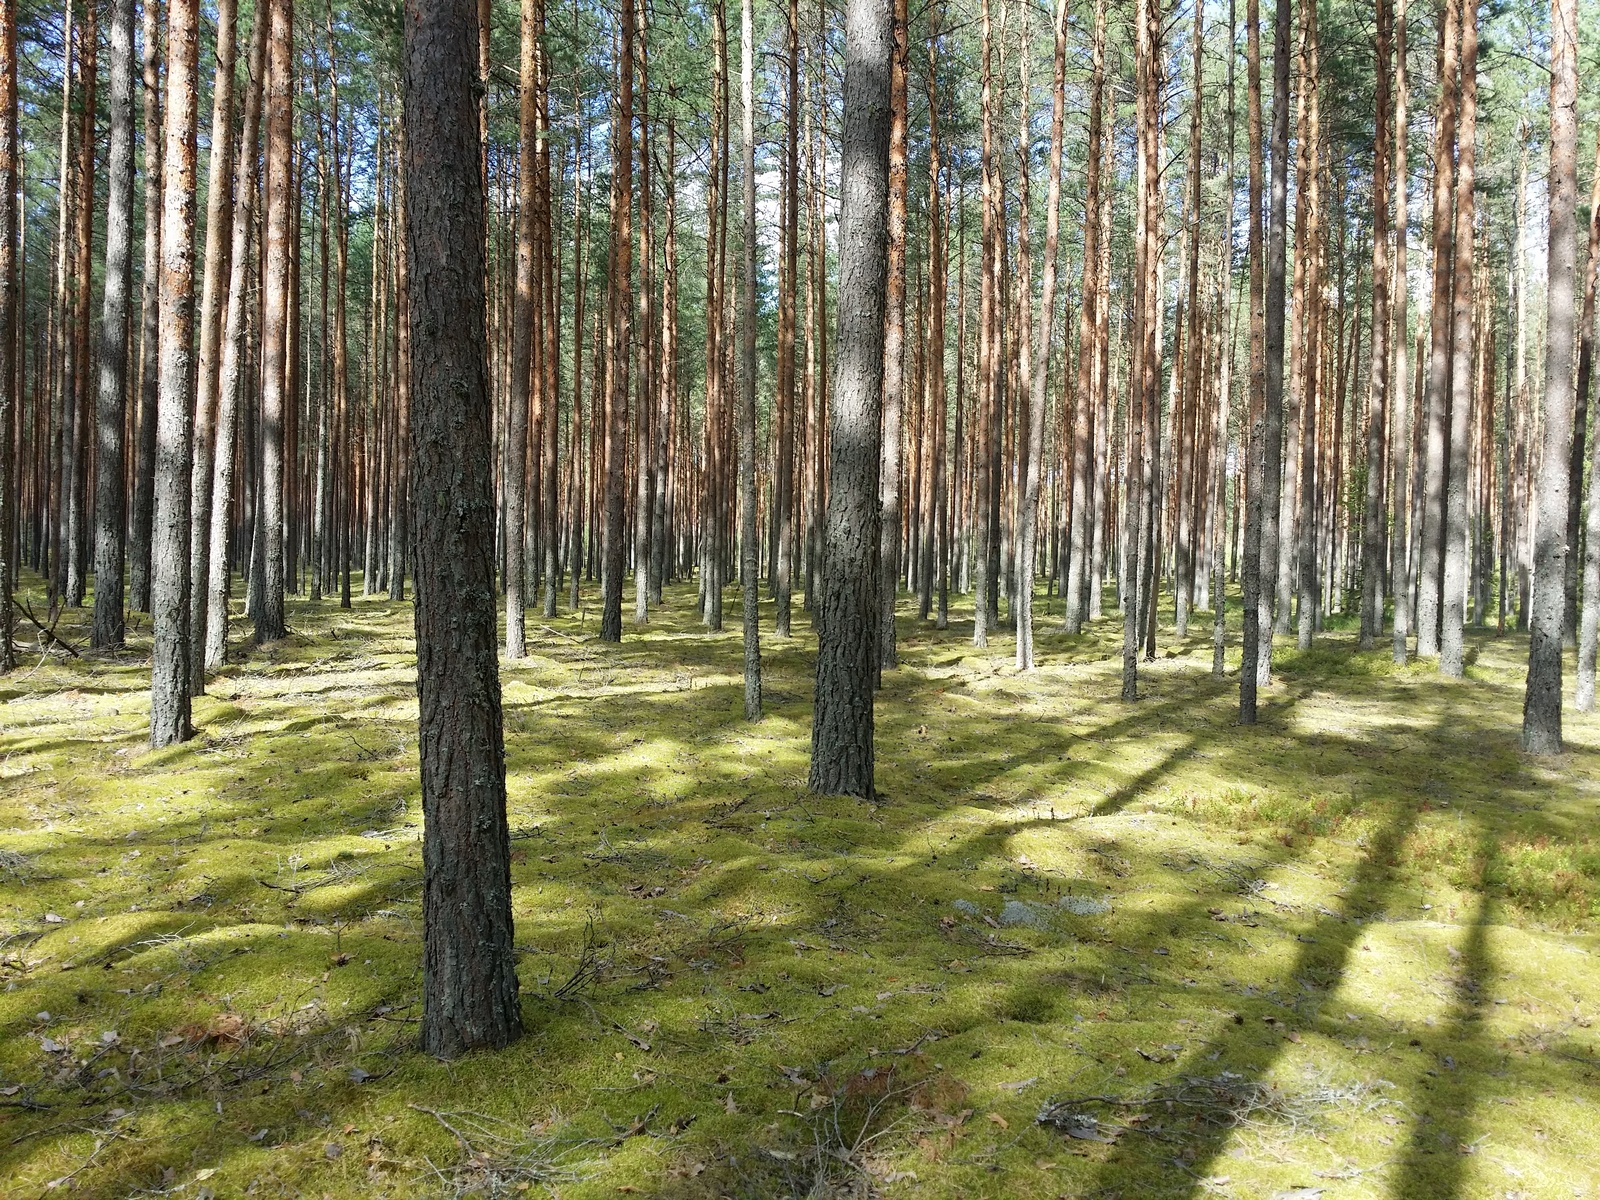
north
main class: Woodland
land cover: Pine dominated coniferous woodland
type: hemiboreal forest and nemoral coniferous forest and mixed broadleaved-coniferous forest
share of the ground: 50 - 75 %
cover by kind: coniferous forest trees 70 %, lichens and mosses 30 %
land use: Forestry
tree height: > 5 m
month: August
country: LV
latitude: 57.3466
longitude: 27.6791
